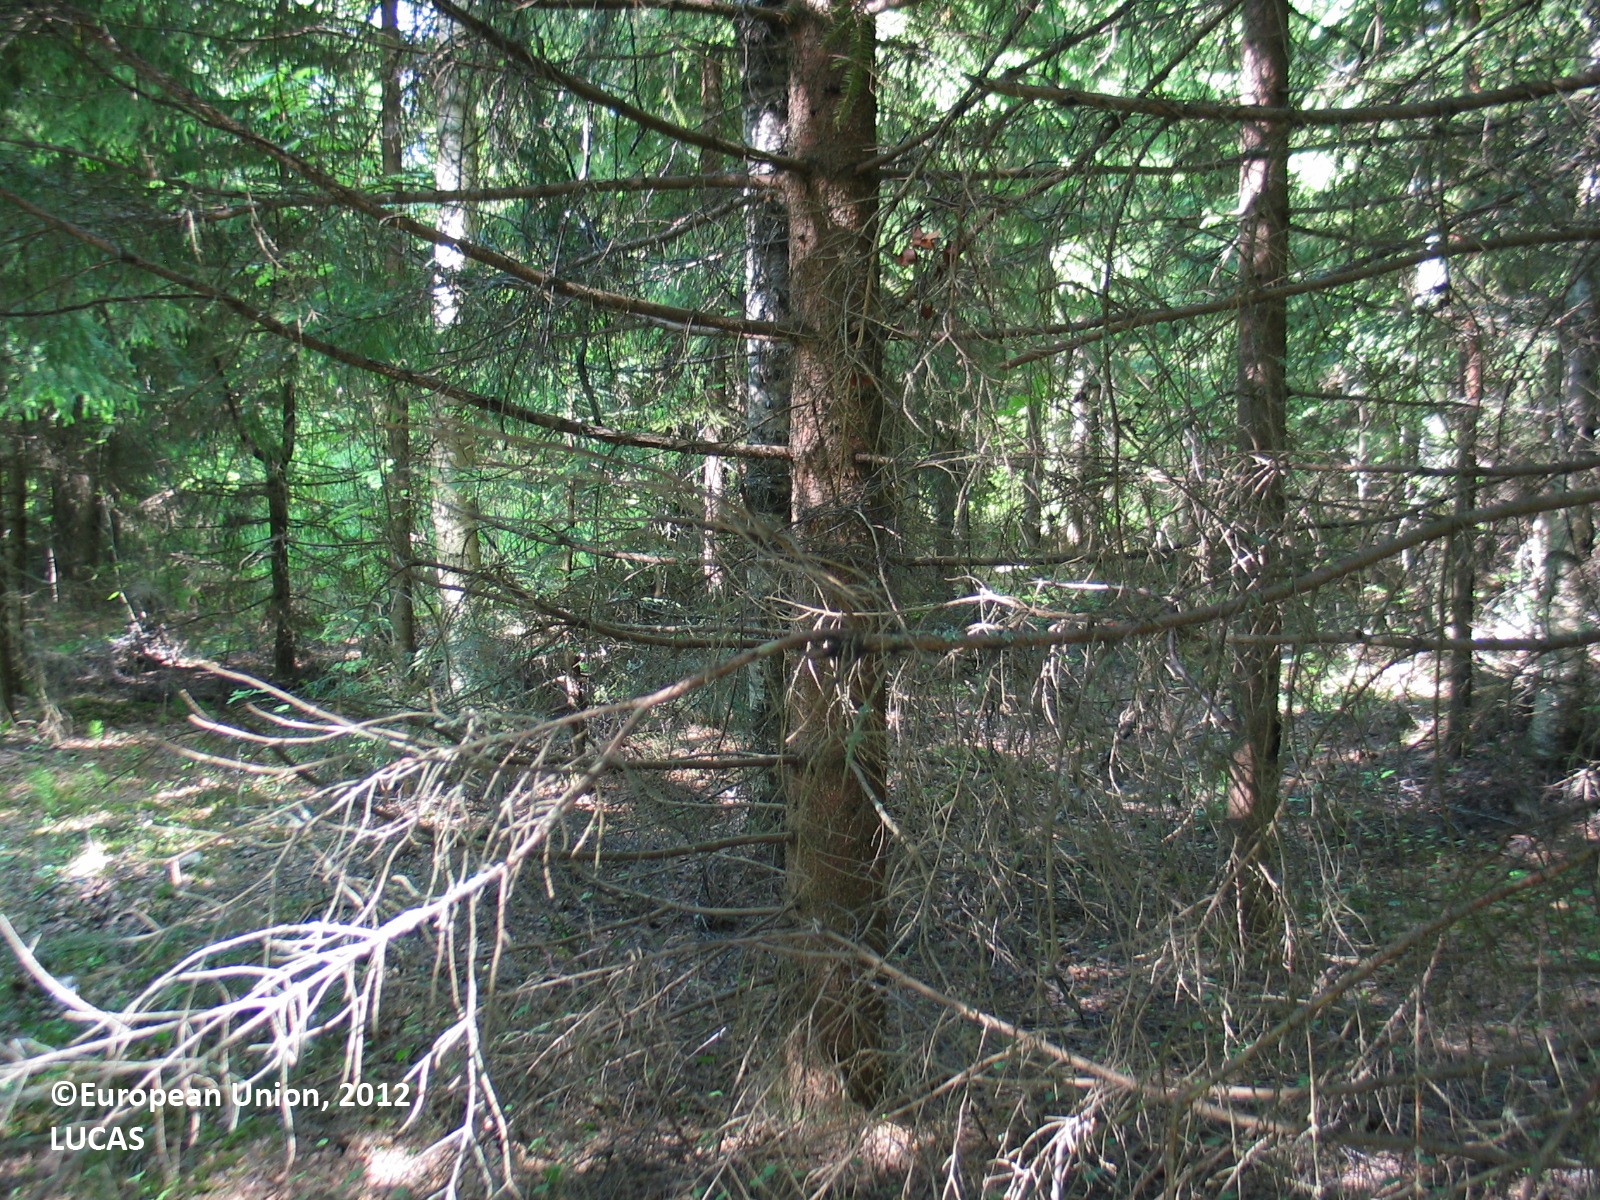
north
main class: Woodland
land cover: Spruce dominated coniferous woodland
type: boreal forest
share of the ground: > 75 %
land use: Forestry
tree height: > 5 m
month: June
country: FI
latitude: 65.1018
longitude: 25.3859
